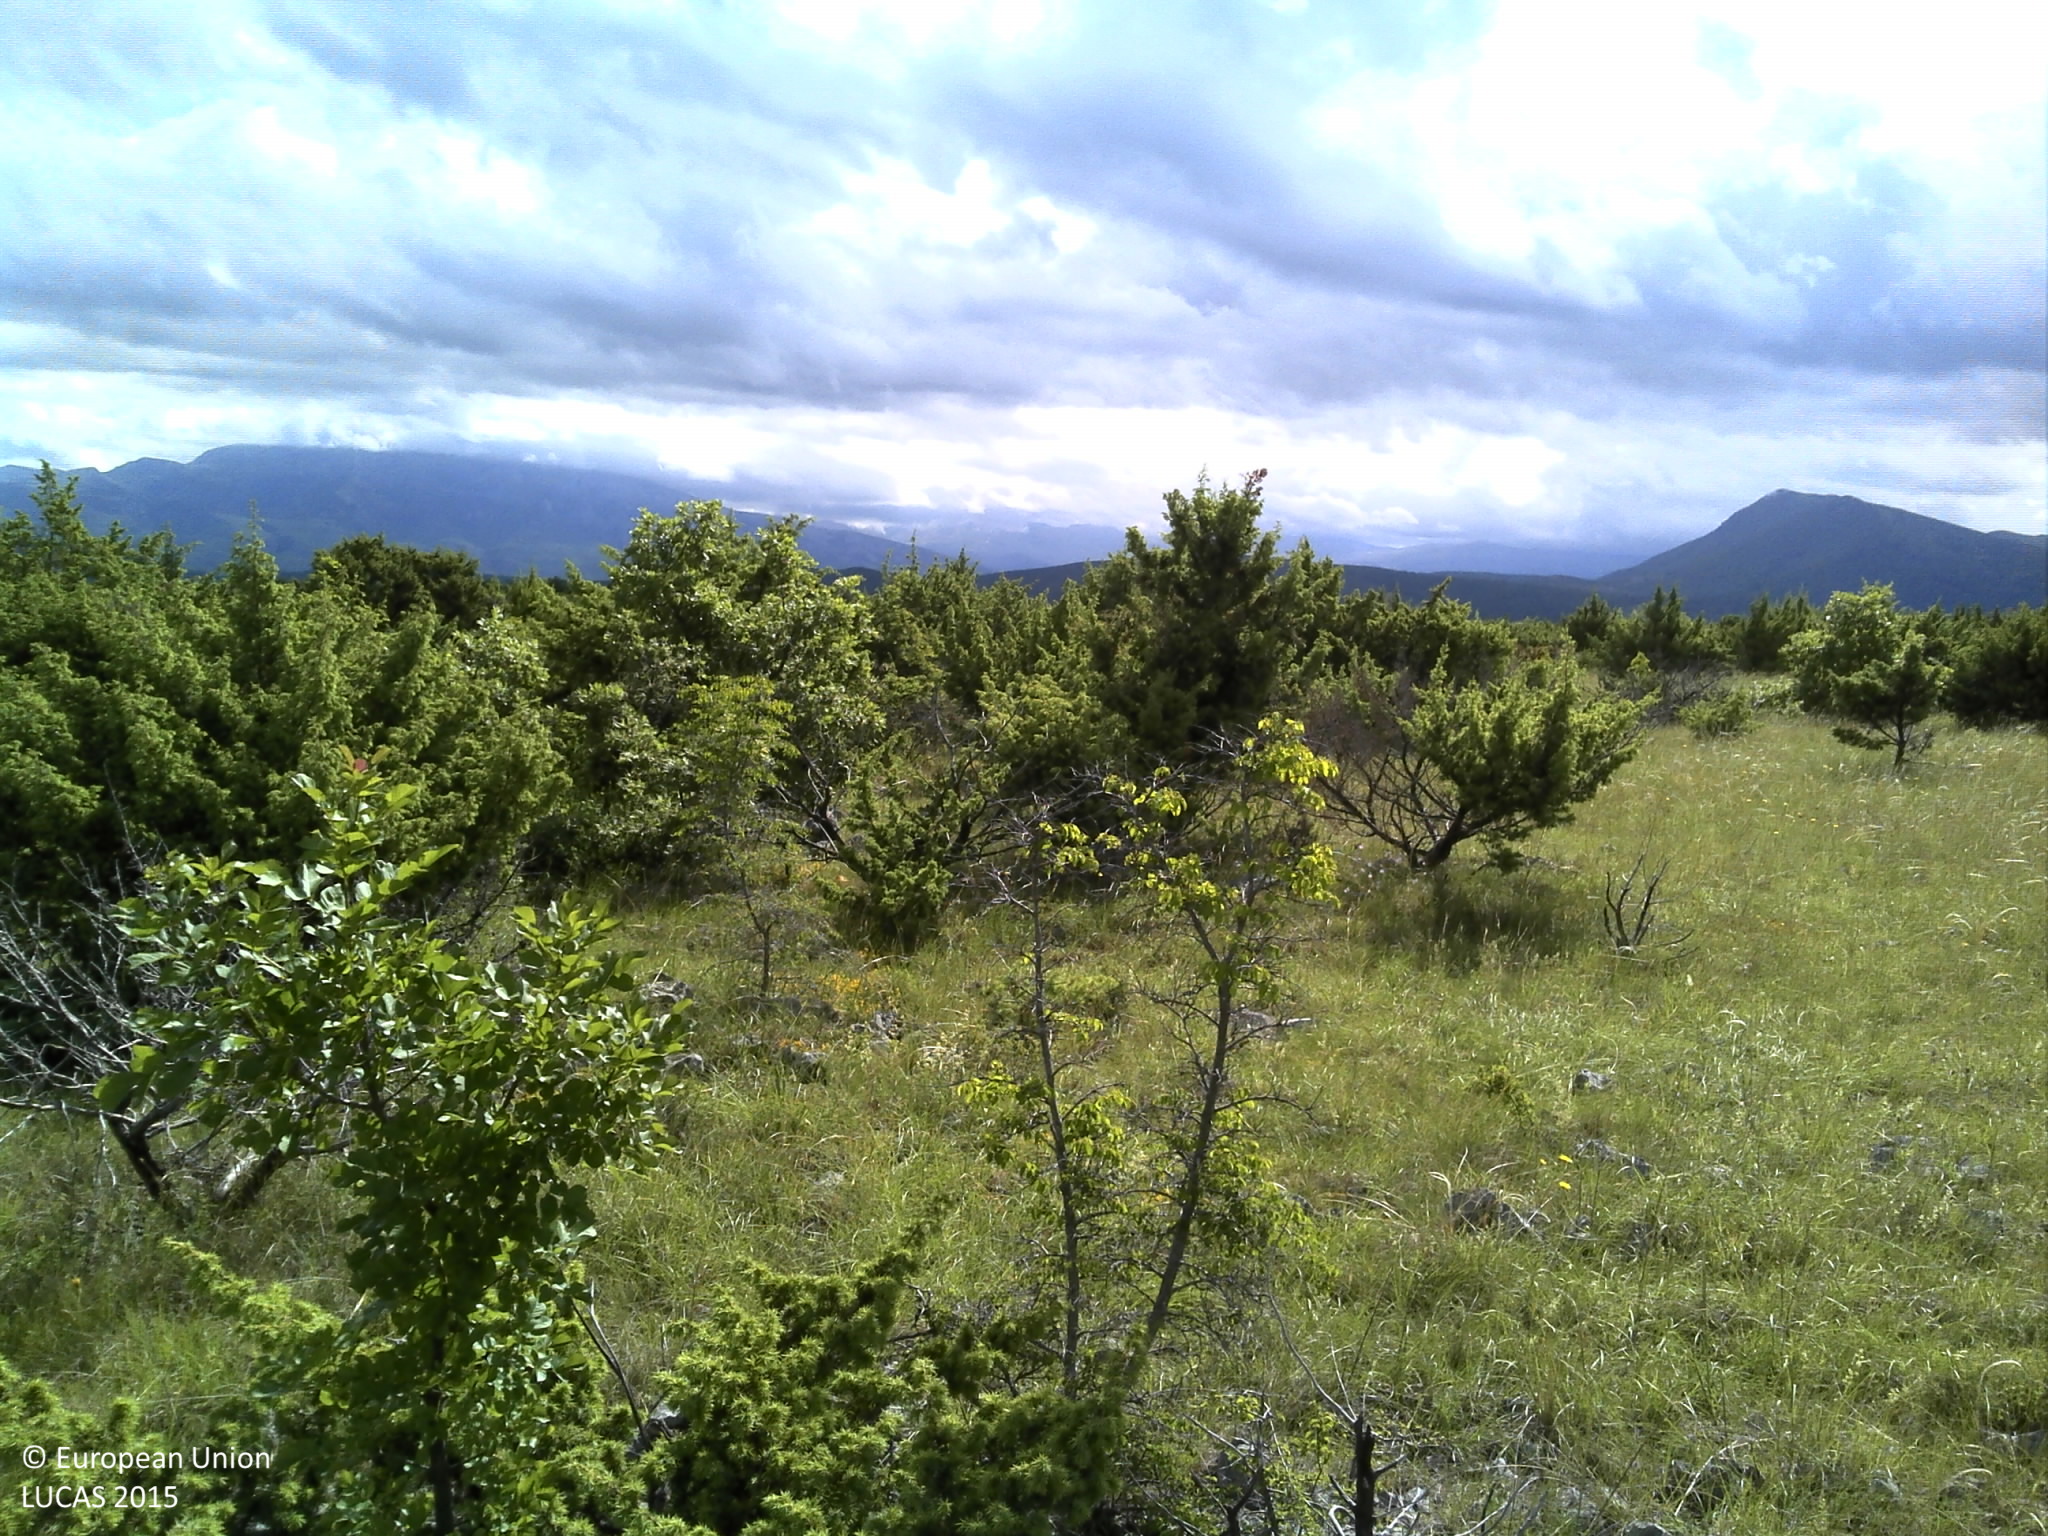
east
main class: Grassland
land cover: Grassland with sparse tree/shrub cover
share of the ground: > 75 %
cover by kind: herbaceous plants 75 %, shrubs 10 %, unconsolidated bare surface 10 %, coniferous forest trees 5 %
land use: Semi-natural and natural areas not in use
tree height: < 5 m
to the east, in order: Grassland with sparse tree/shrub cover; Shrubland without tree cover; Paved roads, cycling and walking lanes; Grassland with sparse tree/shrub cover; Shrubland with sparse tree cover
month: May
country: HR
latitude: 43.9849
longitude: 16.1888
